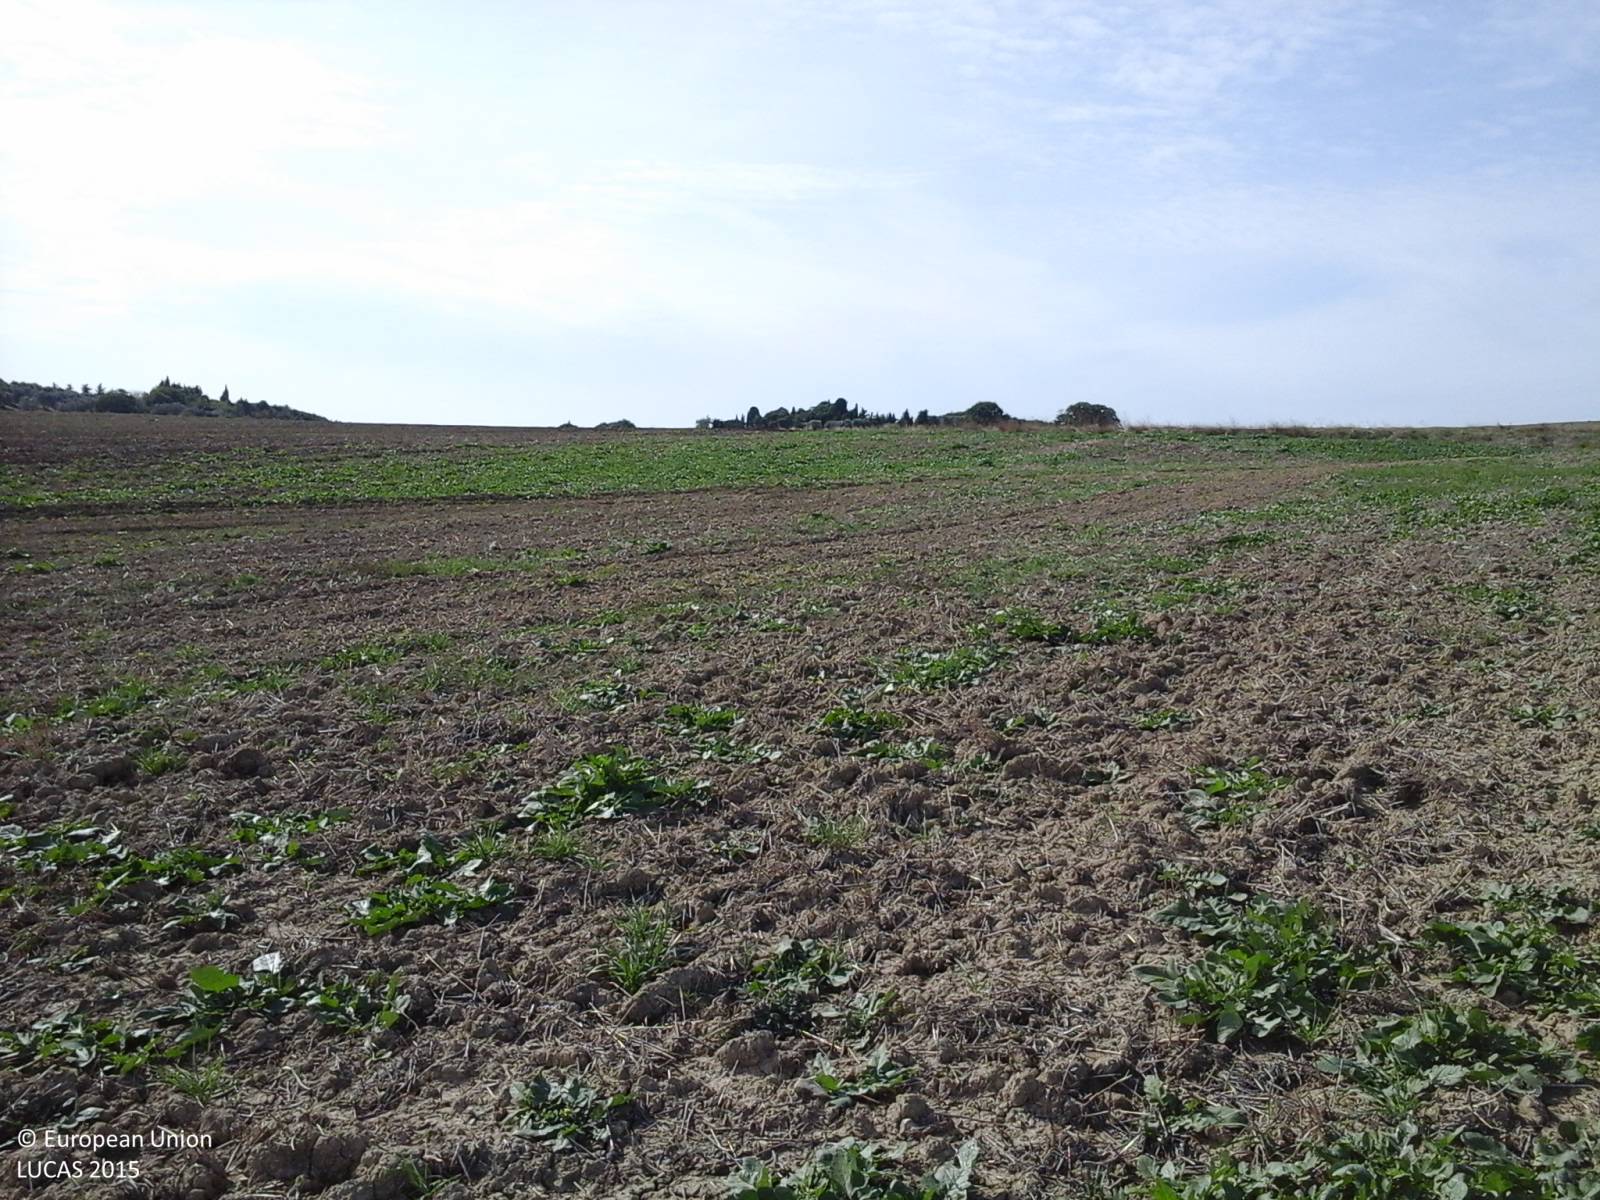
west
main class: Cropland
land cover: Durum wheat
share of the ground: < 10 %
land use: Agriculture (excluding fallow land and kitchen gardens)
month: October
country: IT
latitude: 43.2842
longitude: 10.6021
